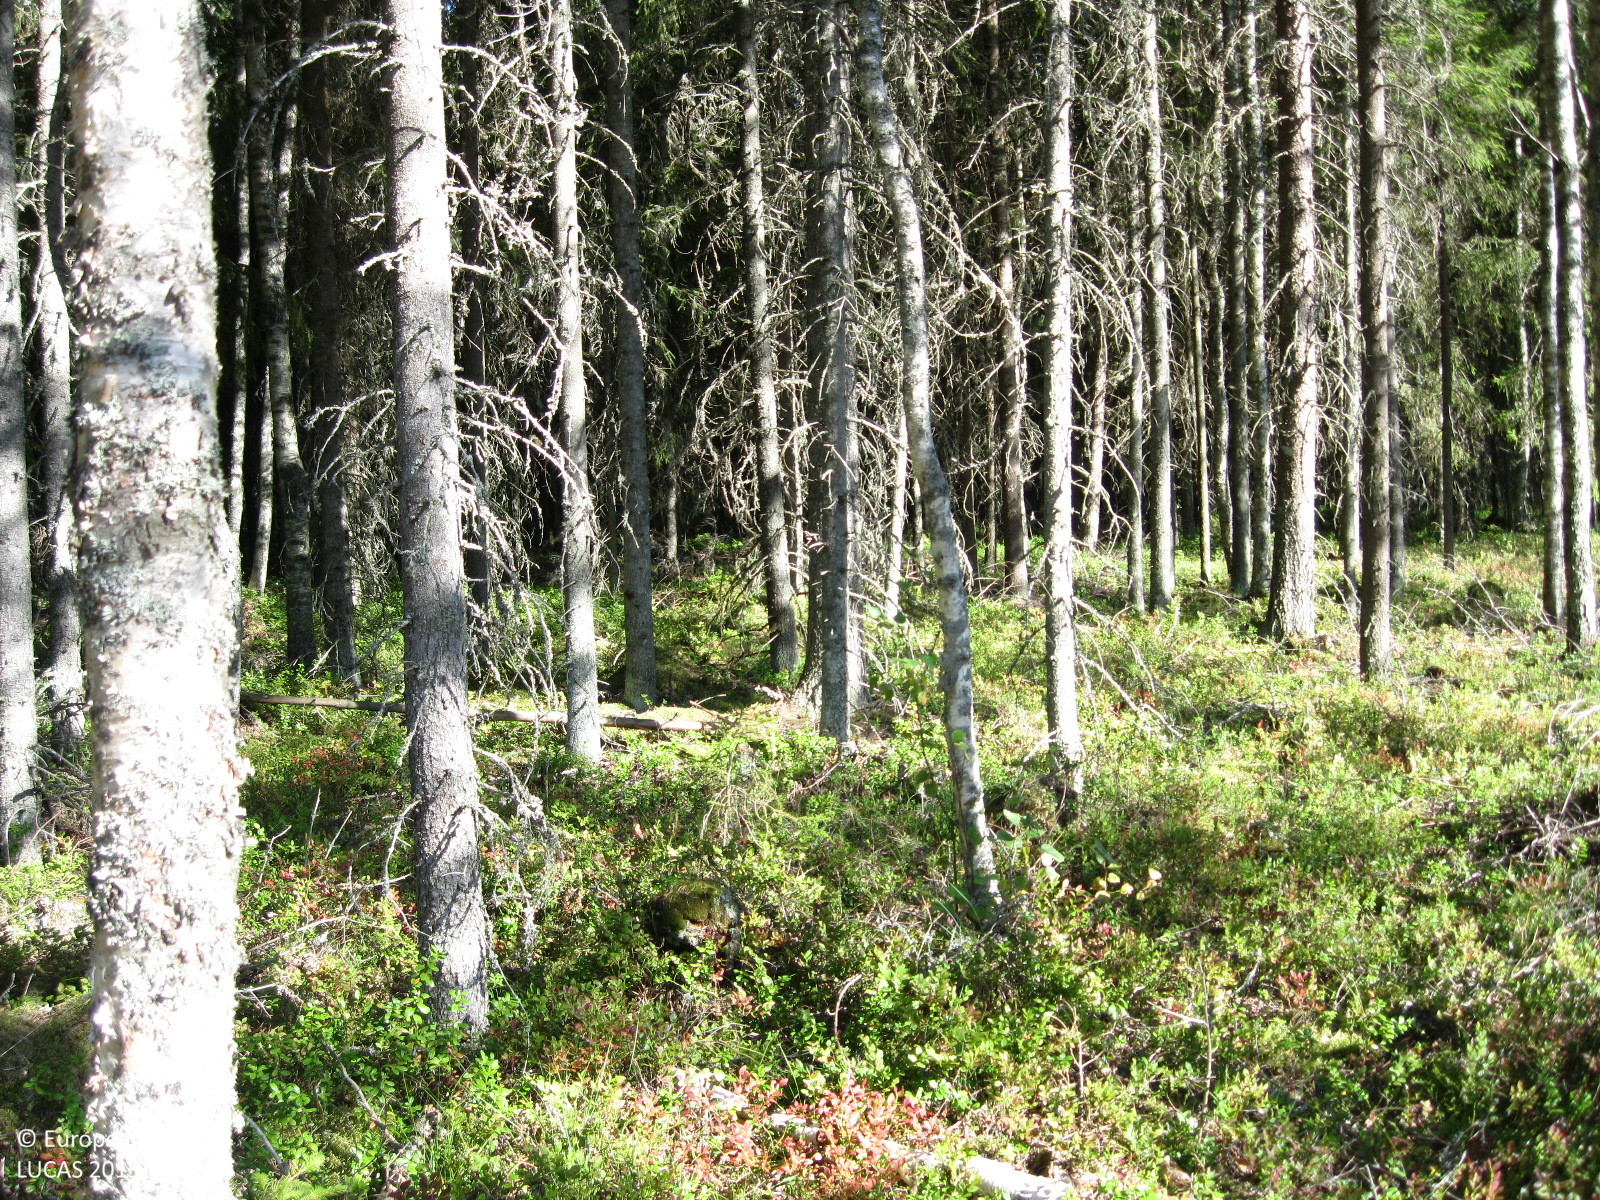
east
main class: Woodland
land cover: Other mixed woodland
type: boreal forest
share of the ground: > 75 %
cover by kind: coniferous forest trees 55 %, broadleaved forest trees 30 %, shrubs 15 %
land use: Forestry
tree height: > 5 m
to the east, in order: Other mixed woodland; Ditches and canals; Other mixed woodland; Ditches and canals; Other mixed woodland; Spruce dominated mixed woodland
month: August
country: FI
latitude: 61.2552
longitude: 25.2725
